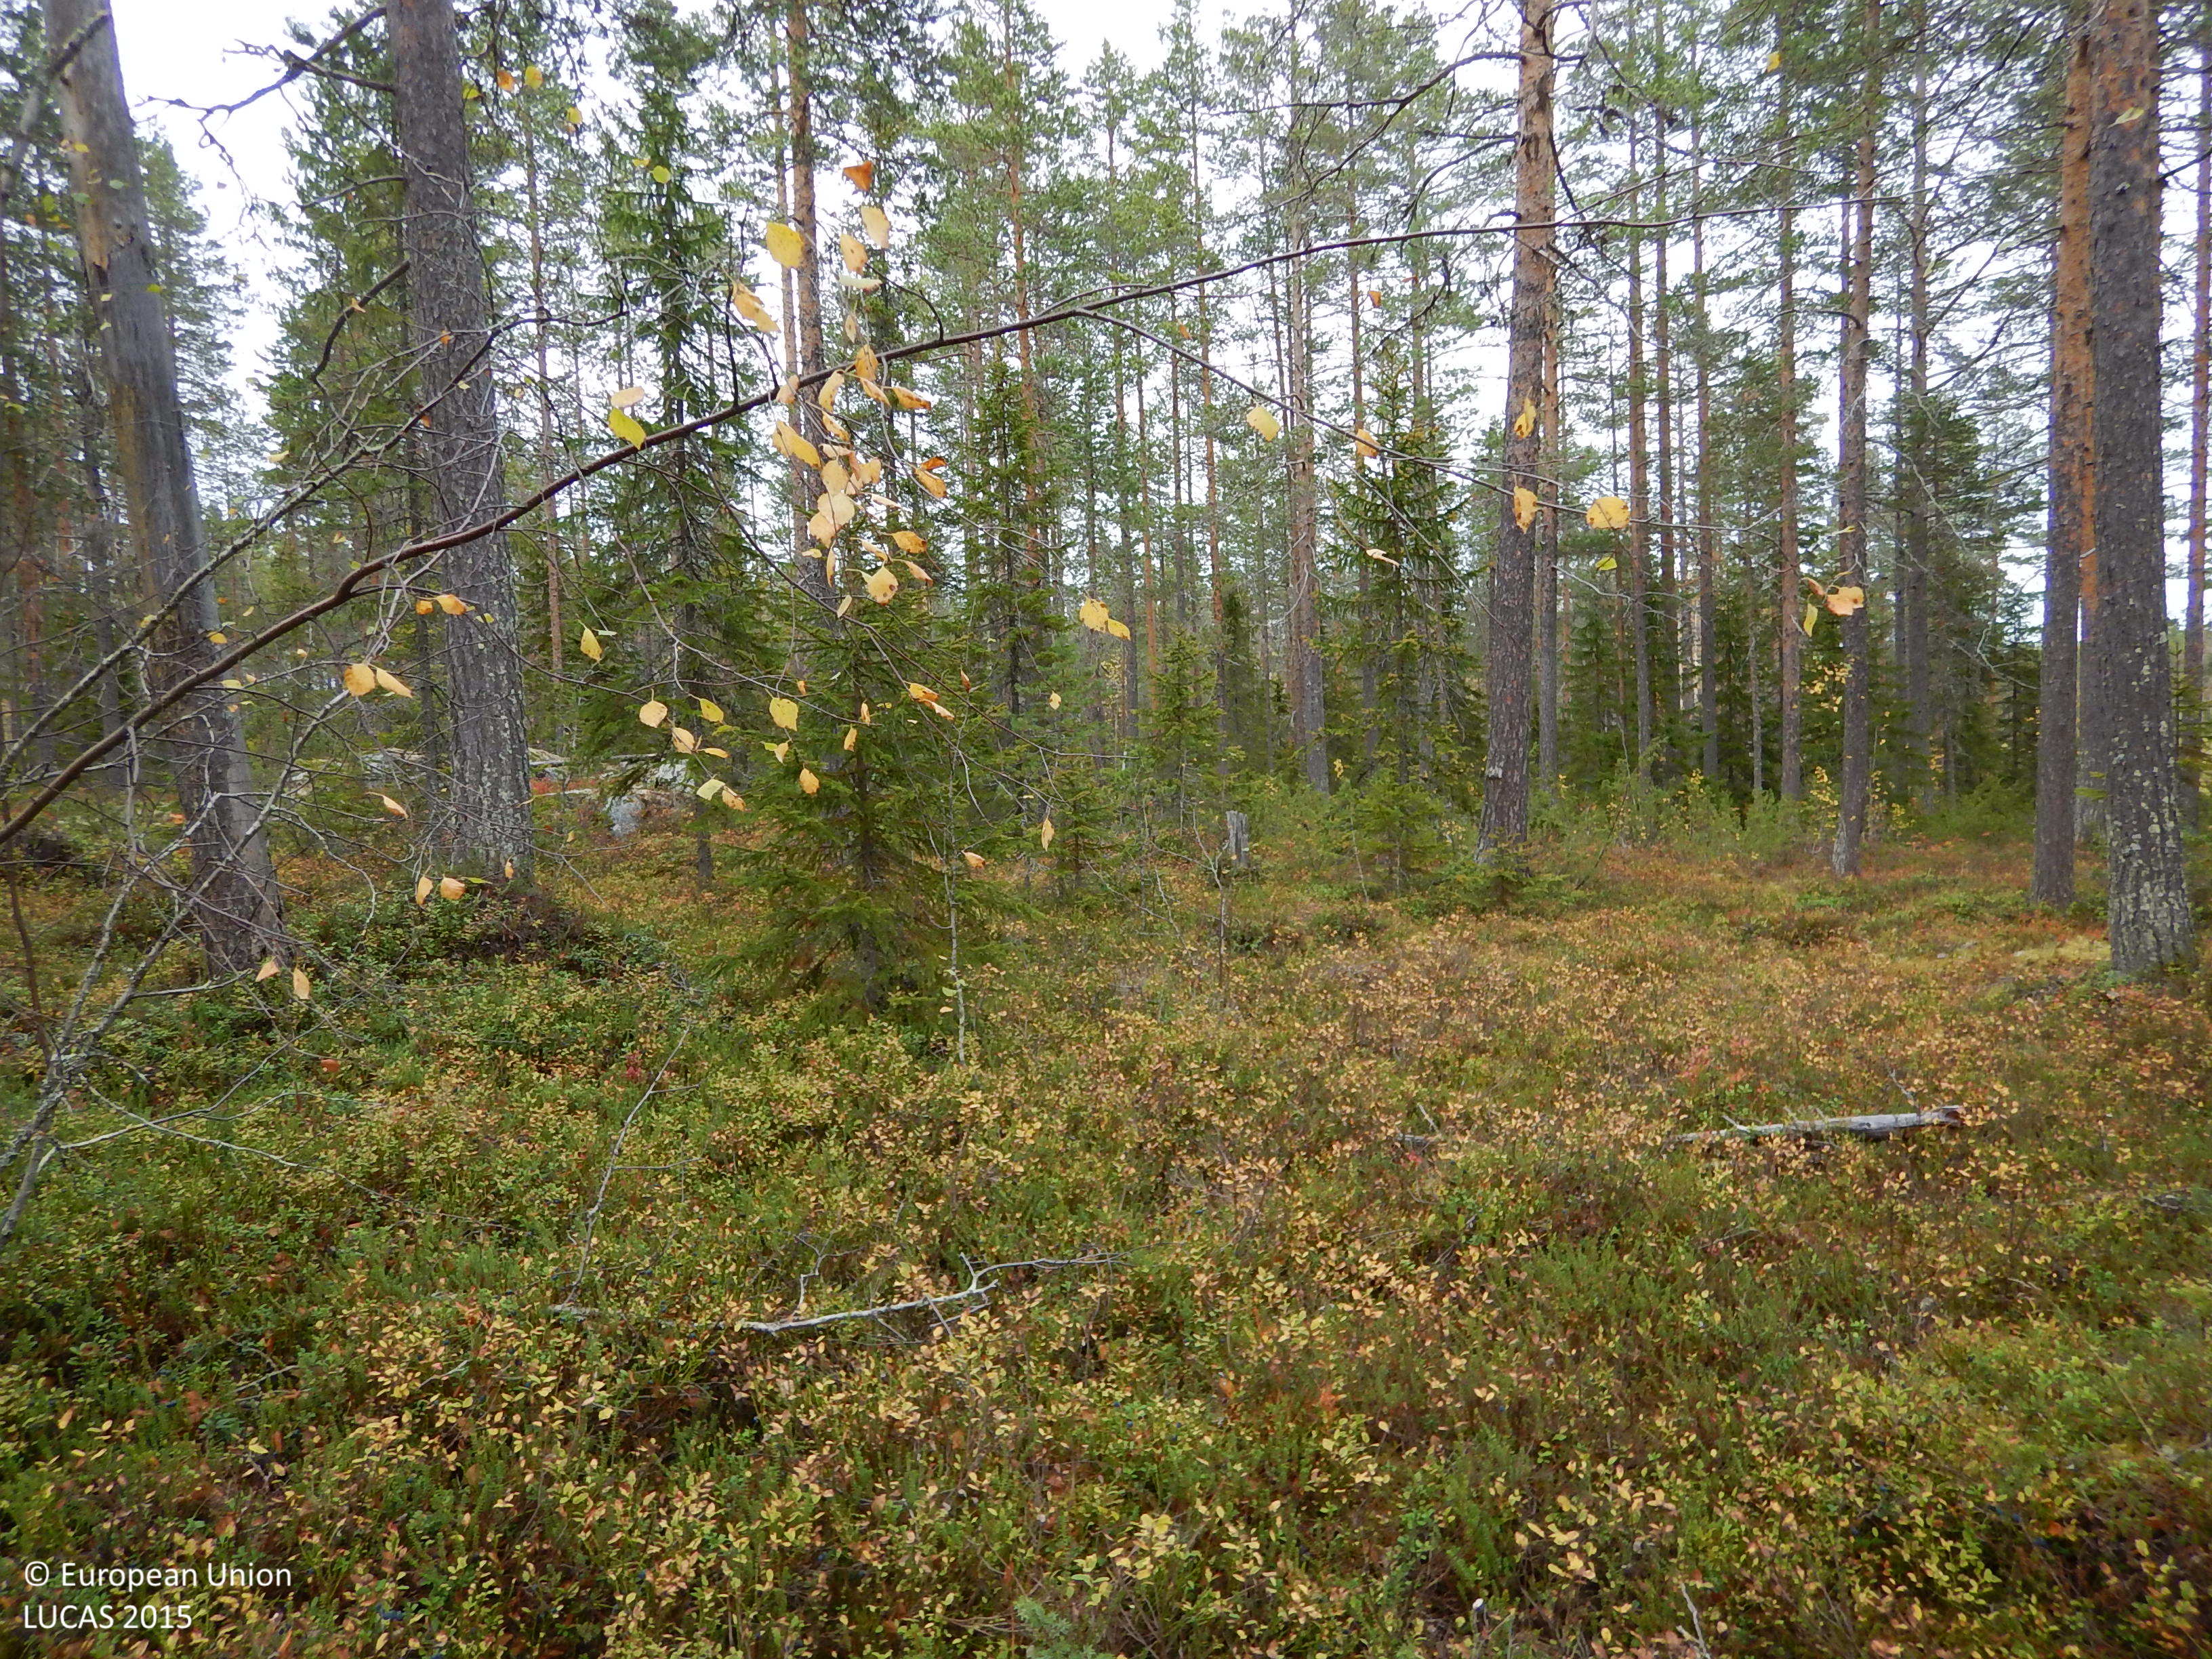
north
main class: Woodland
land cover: Pine dominated coniferous woodland
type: boreal forest
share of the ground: 50 - 75 %
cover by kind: coniferous forest trees 55 %, shrubs 20 %, herbaceous plants 10 %, lichens and mosses 10 %, broadleaved forest trees 5 %
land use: Forestry
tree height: > 5 m
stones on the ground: < 10 %
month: October
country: SE
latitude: 64.8566
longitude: 20.7118
